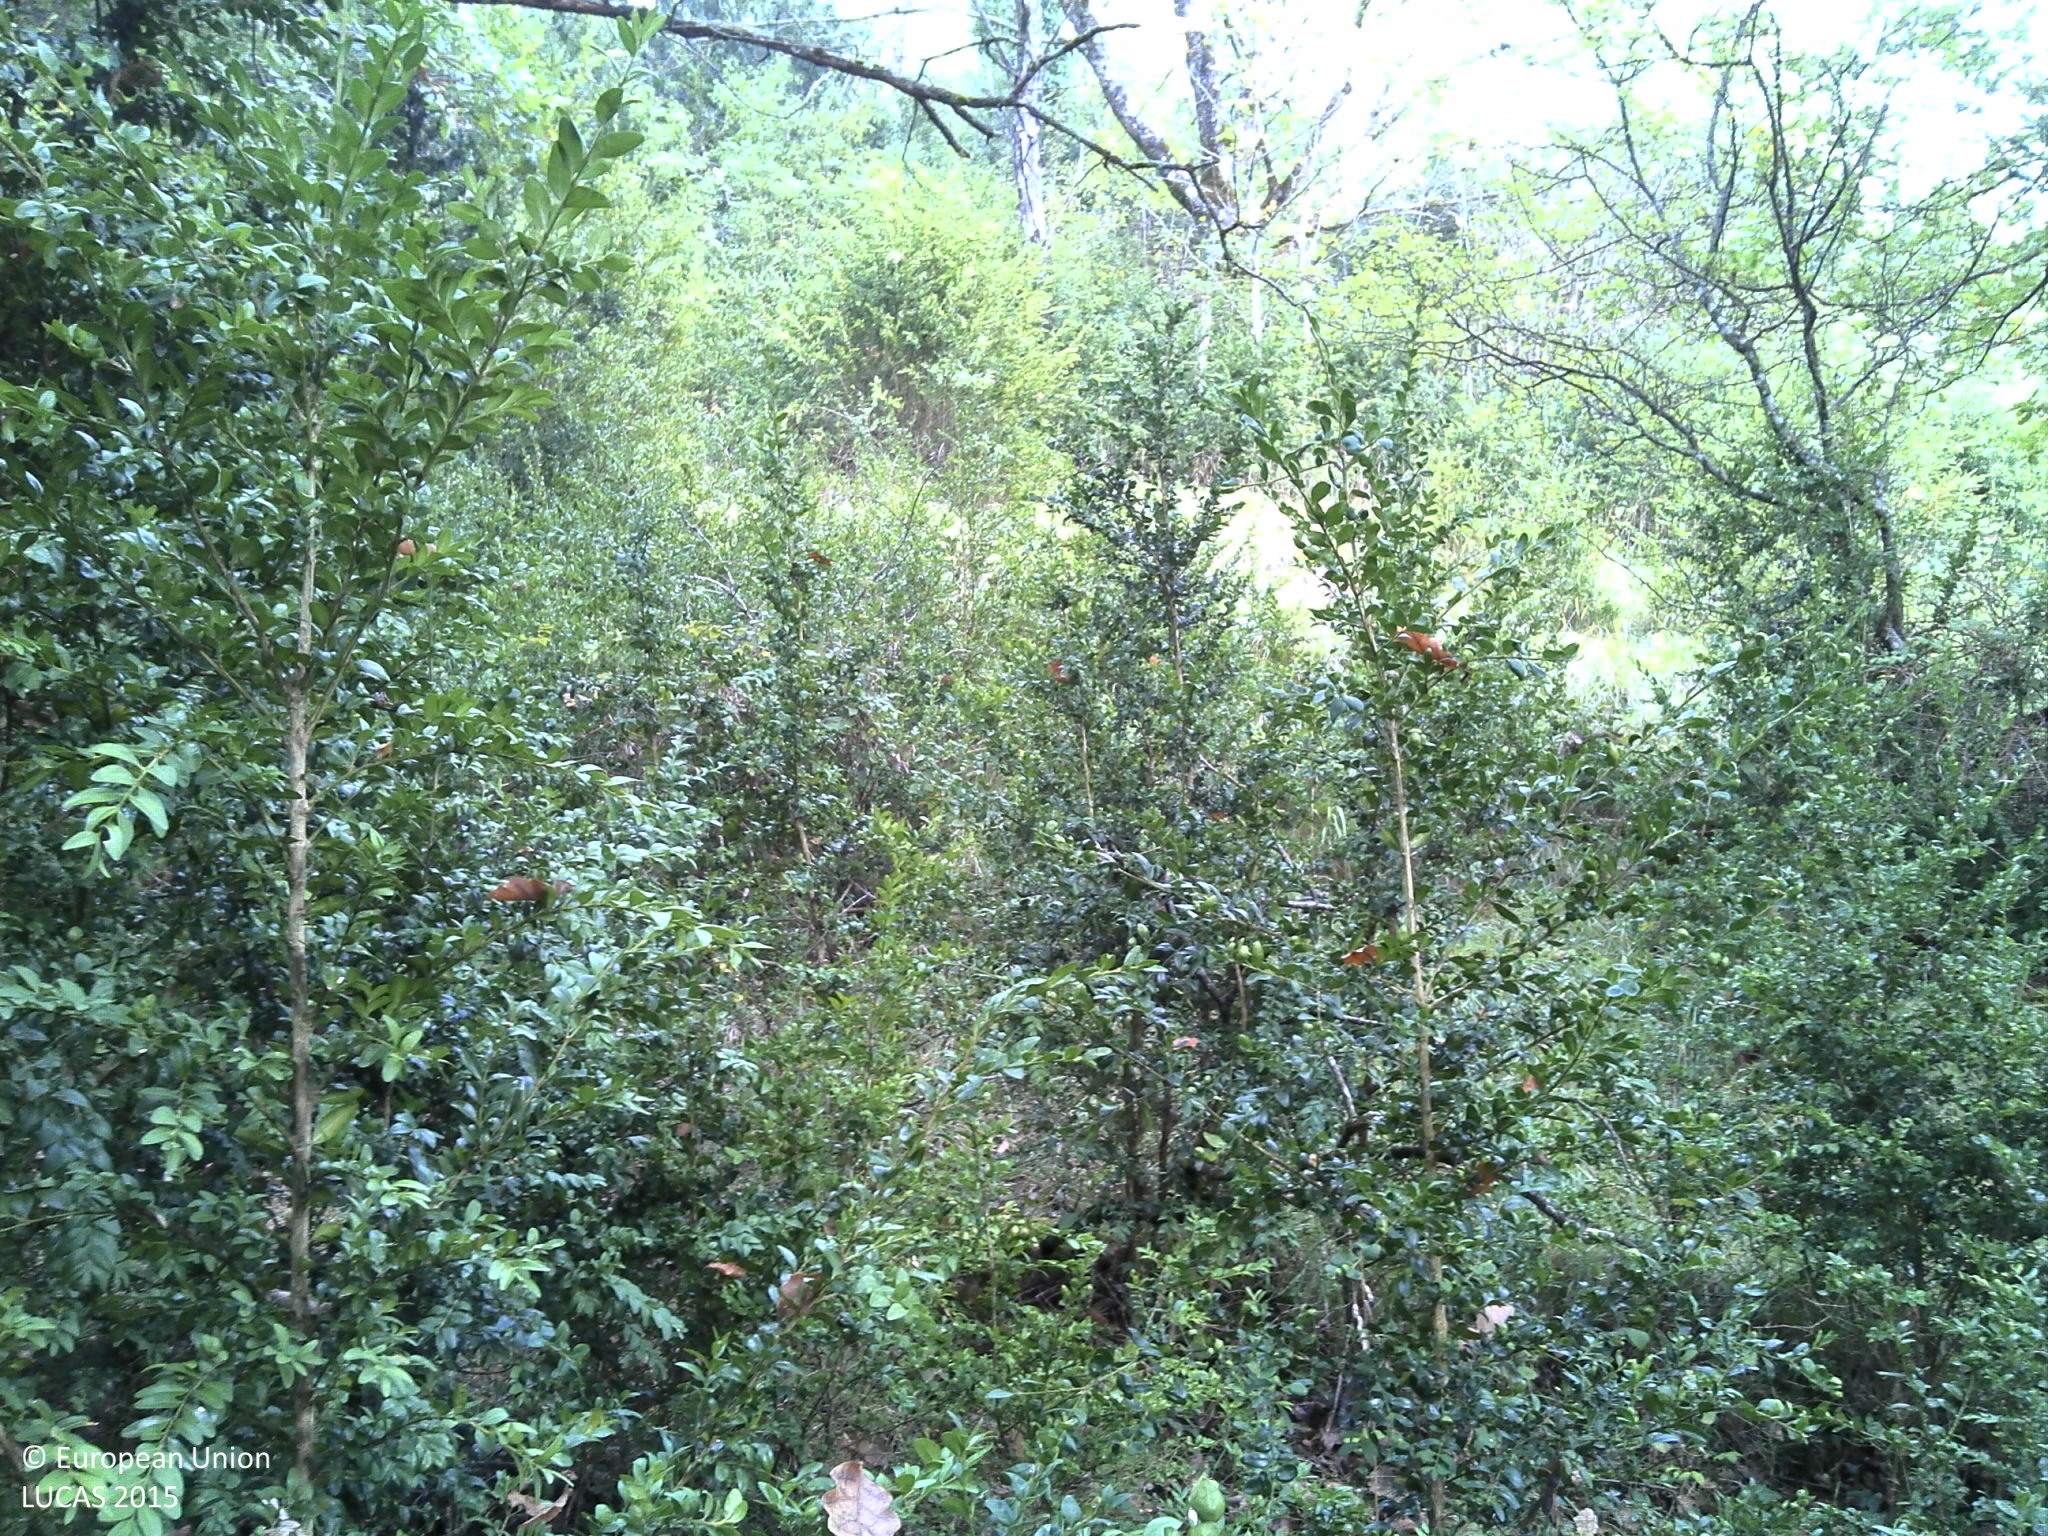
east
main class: Woodland
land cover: Broadleaved woodland
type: acidophilous oak and oak-birch forest
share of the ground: 50 - 75 %
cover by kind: broadleaved forest trees 50 %, herbaceous plants 30 %, shrubs 20 %
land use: Forestry
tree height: > 5 m
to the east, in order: Broadleaved woodland; Tracks; Rocks and stones; Fences; Broadleaved woodland; Rocks and stones; Broadleaved woodland
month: October
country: FR
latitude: 46.3241
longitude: 5.3920
